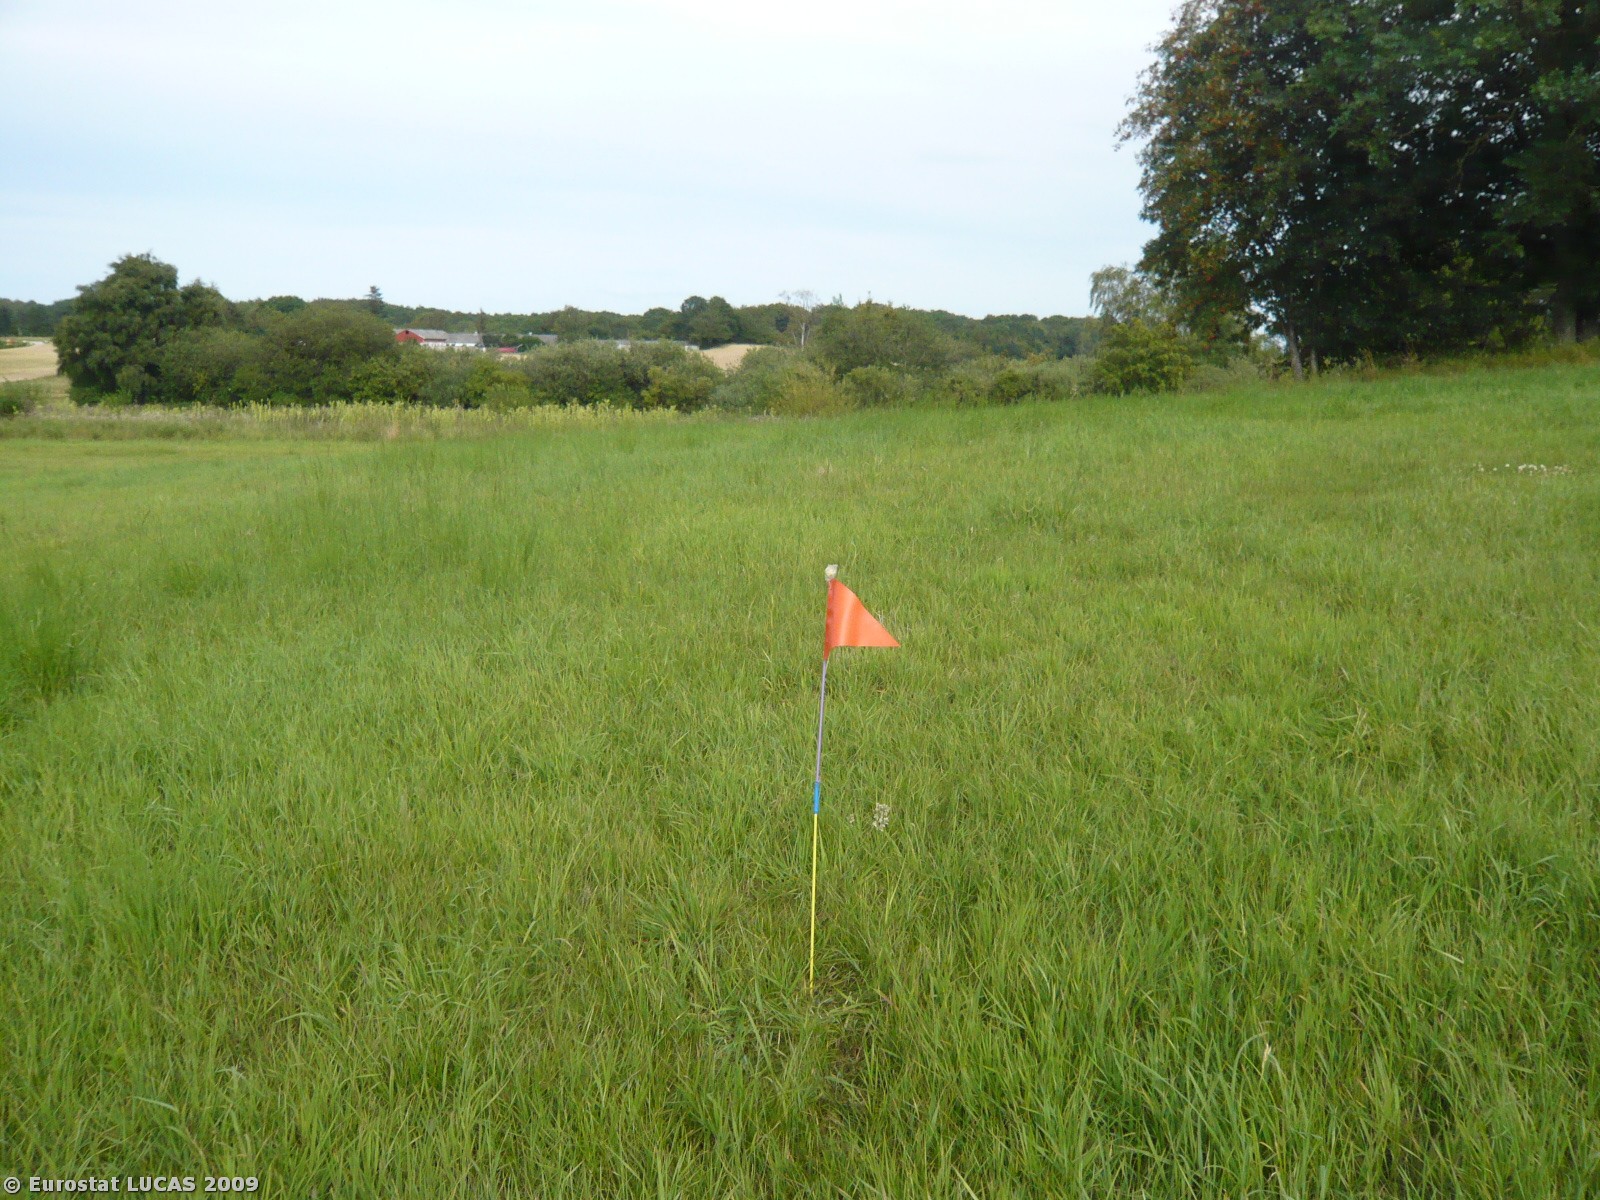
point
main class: Grassland
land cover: Grassland without tree/shrub cover
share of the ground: > 75 %
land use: Agriculture (excluding fallow land and kitchen gardens)
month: August
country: DK
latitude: 56.0582
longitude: 12.3584
